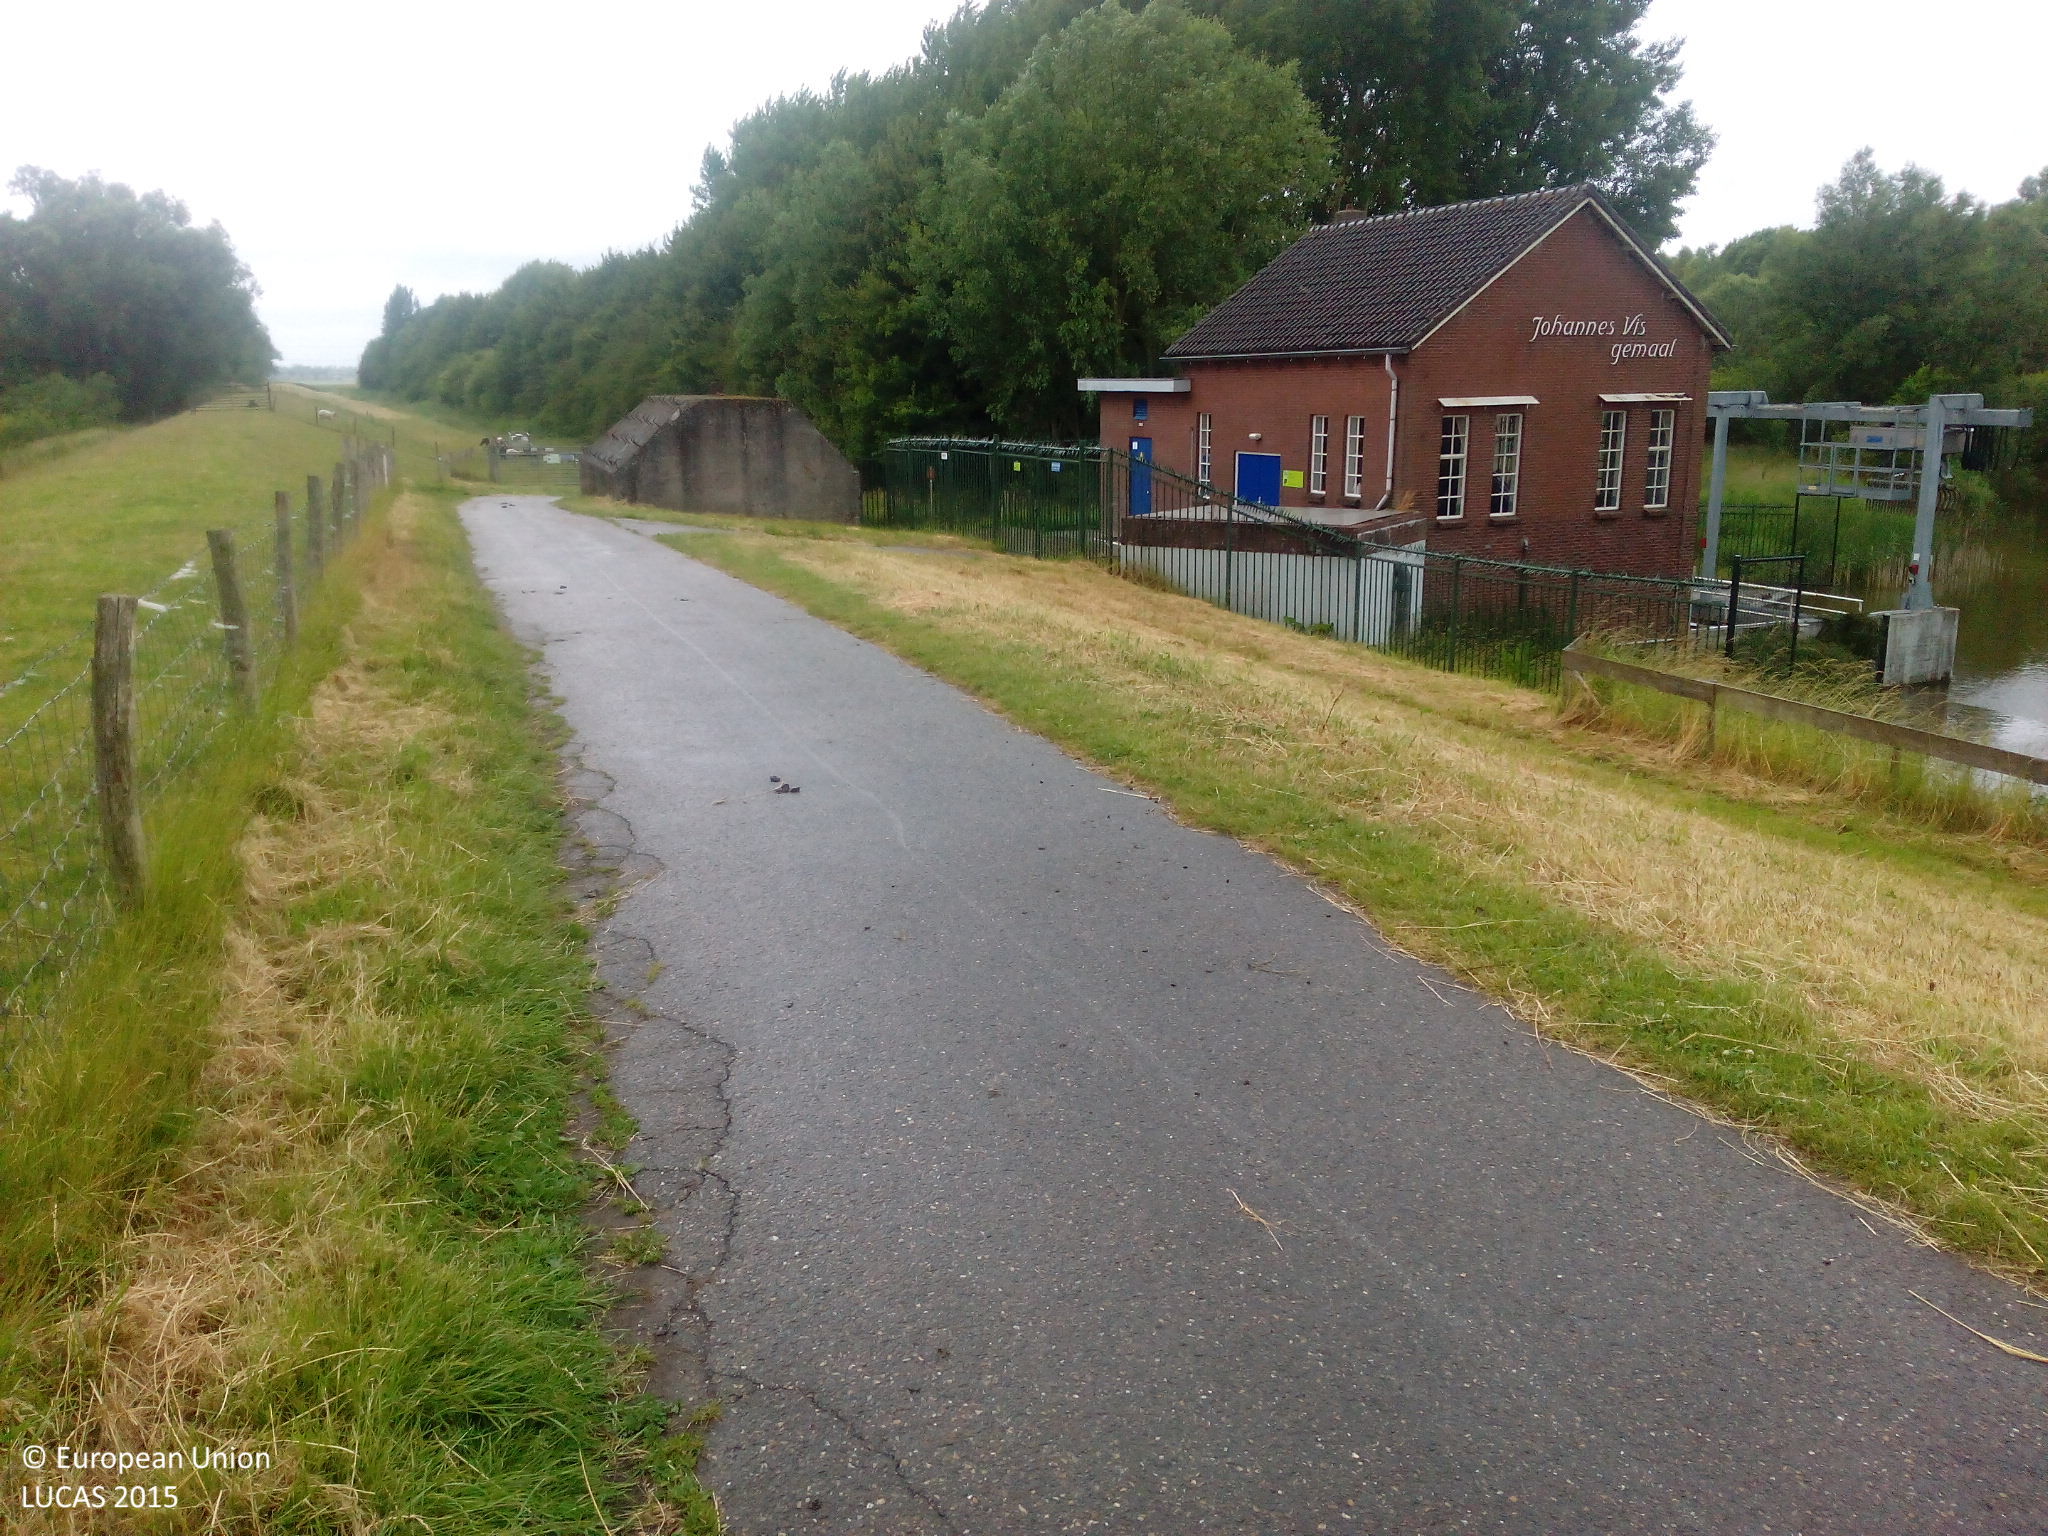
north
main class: Woodland
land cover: Broadleaved woodland
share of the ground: > 75 %
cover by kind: broadleaved forest trees 90 %, herbaceous plants 10 %
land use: Semi-natural and natural areas not in use
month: June
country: NL
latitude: 51.7538
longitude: 4.6799
